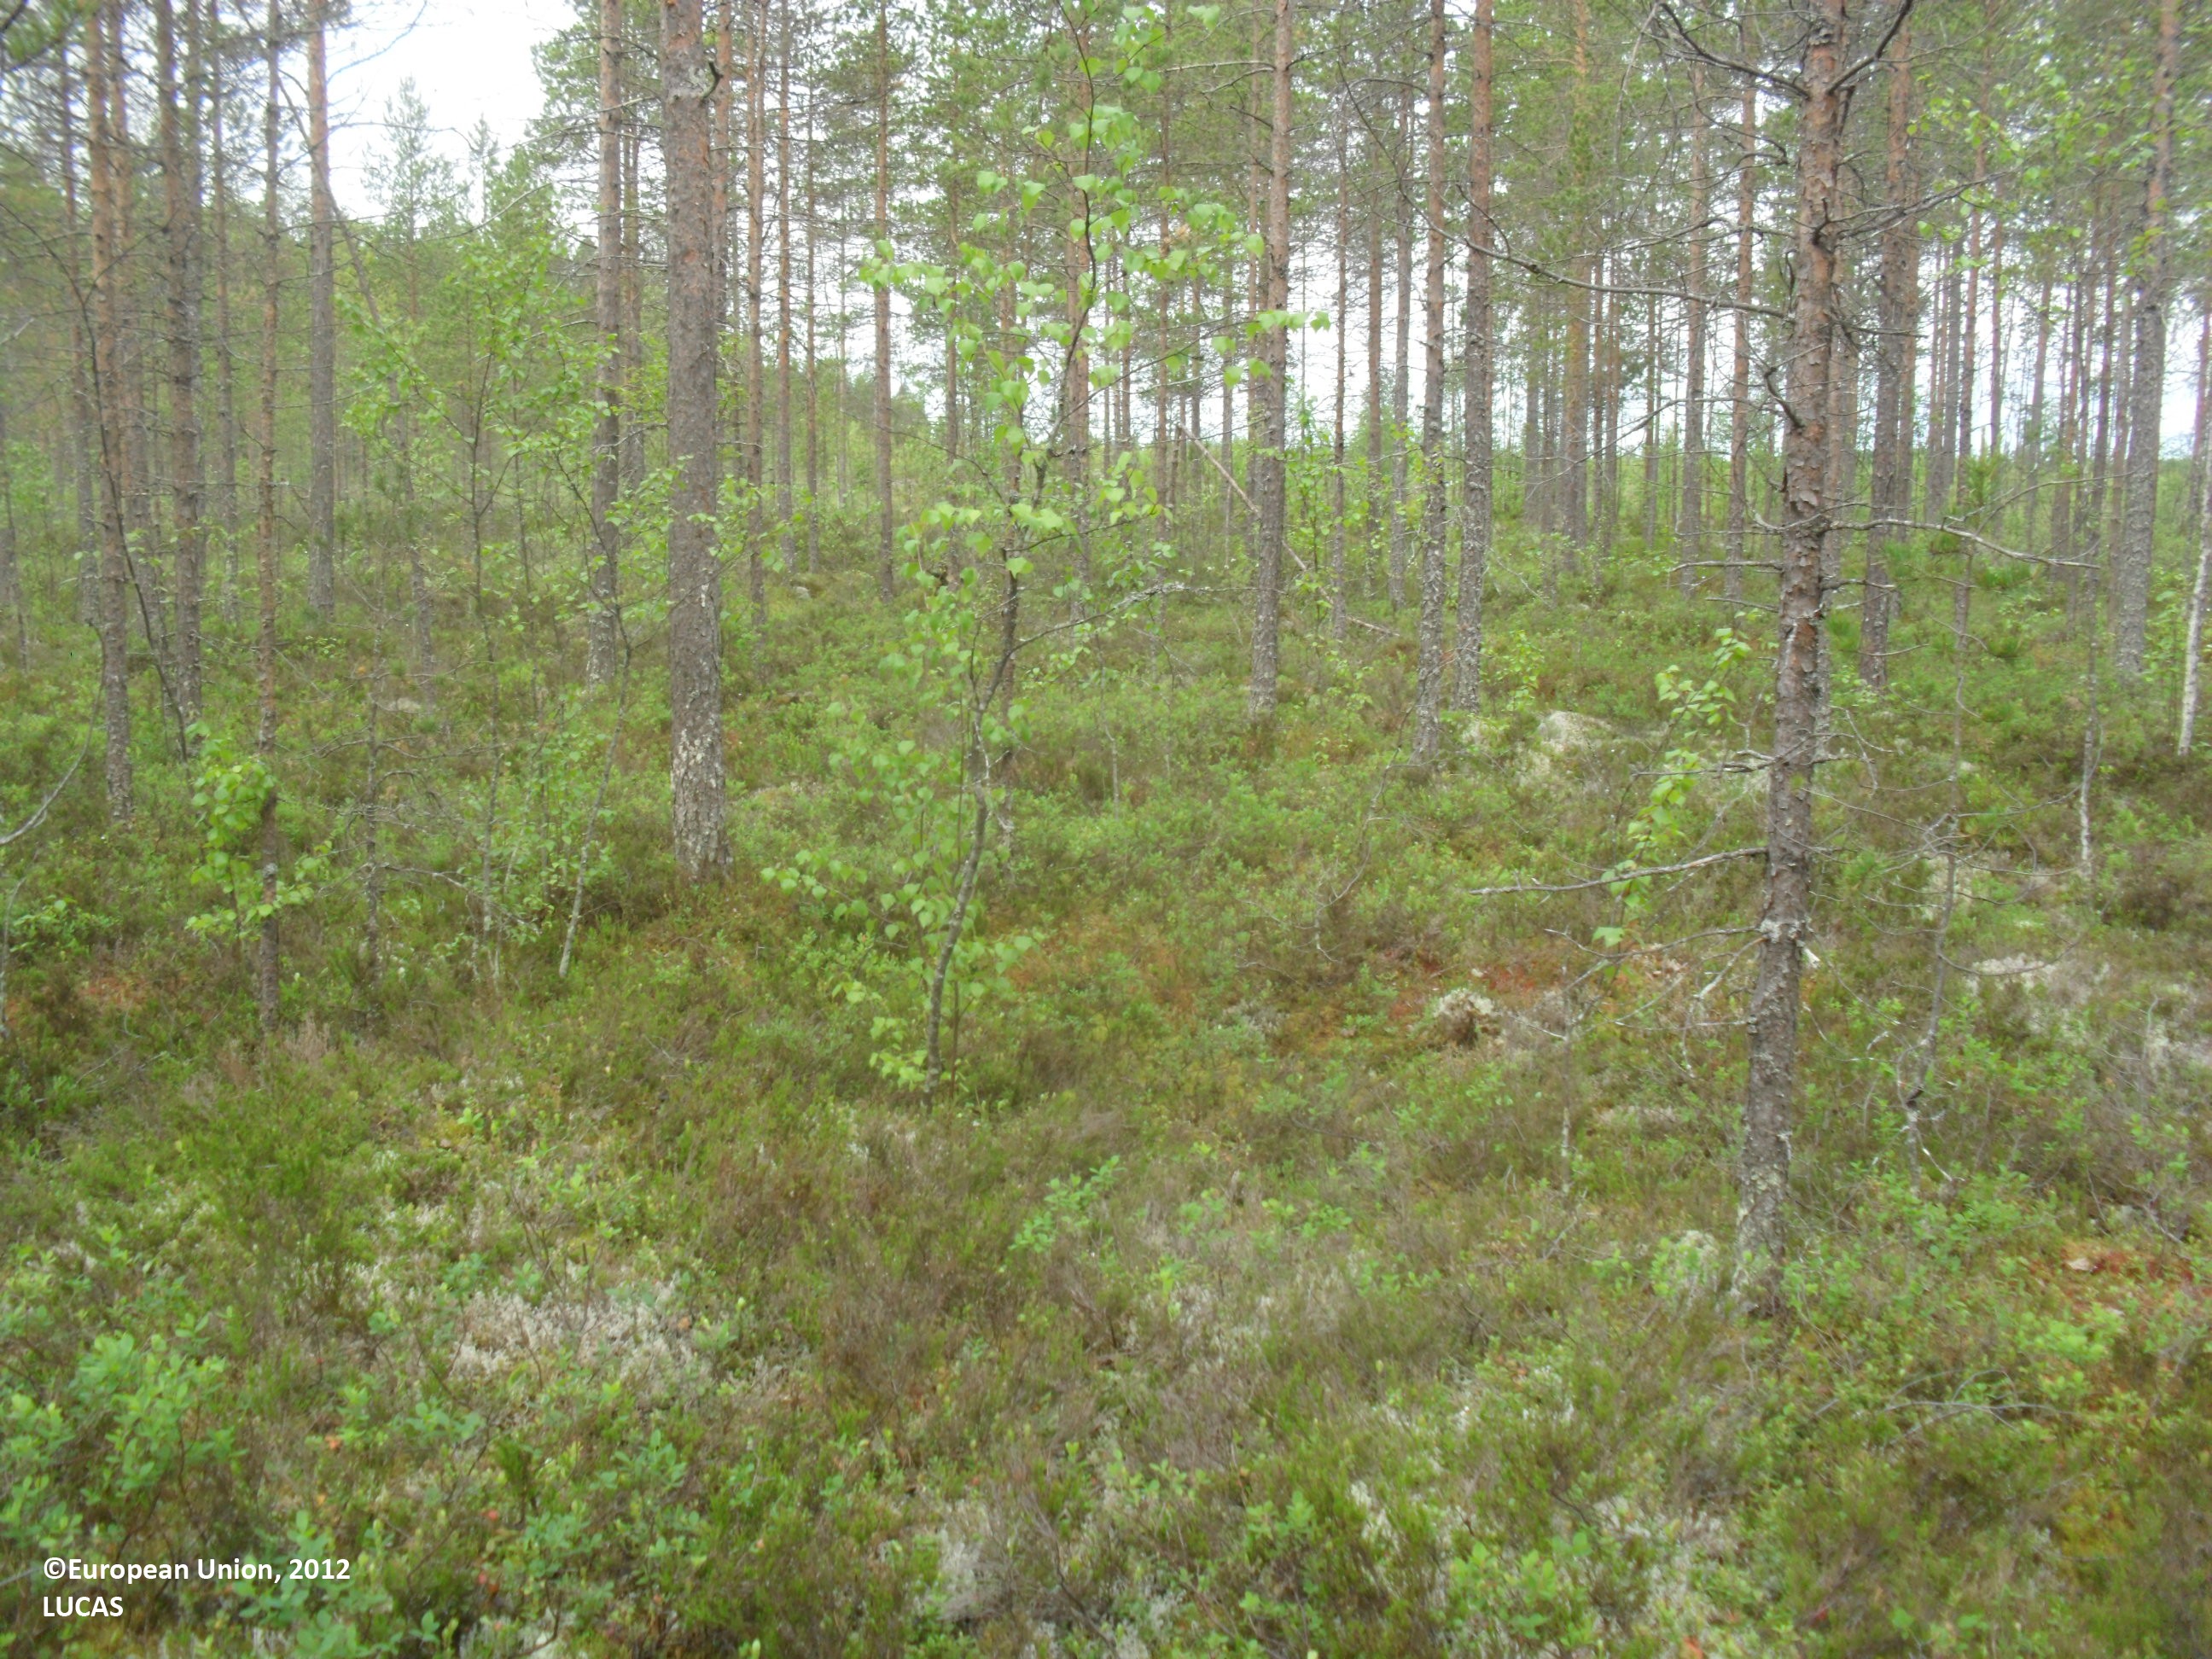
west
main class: Woodland
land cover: Pine dominated coniferous woodland
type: boreal forest
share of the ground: 25 - 50 %
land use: Forestry
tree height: > 5 m
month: June
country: FI
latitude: 62.8431
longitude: 23.7205
